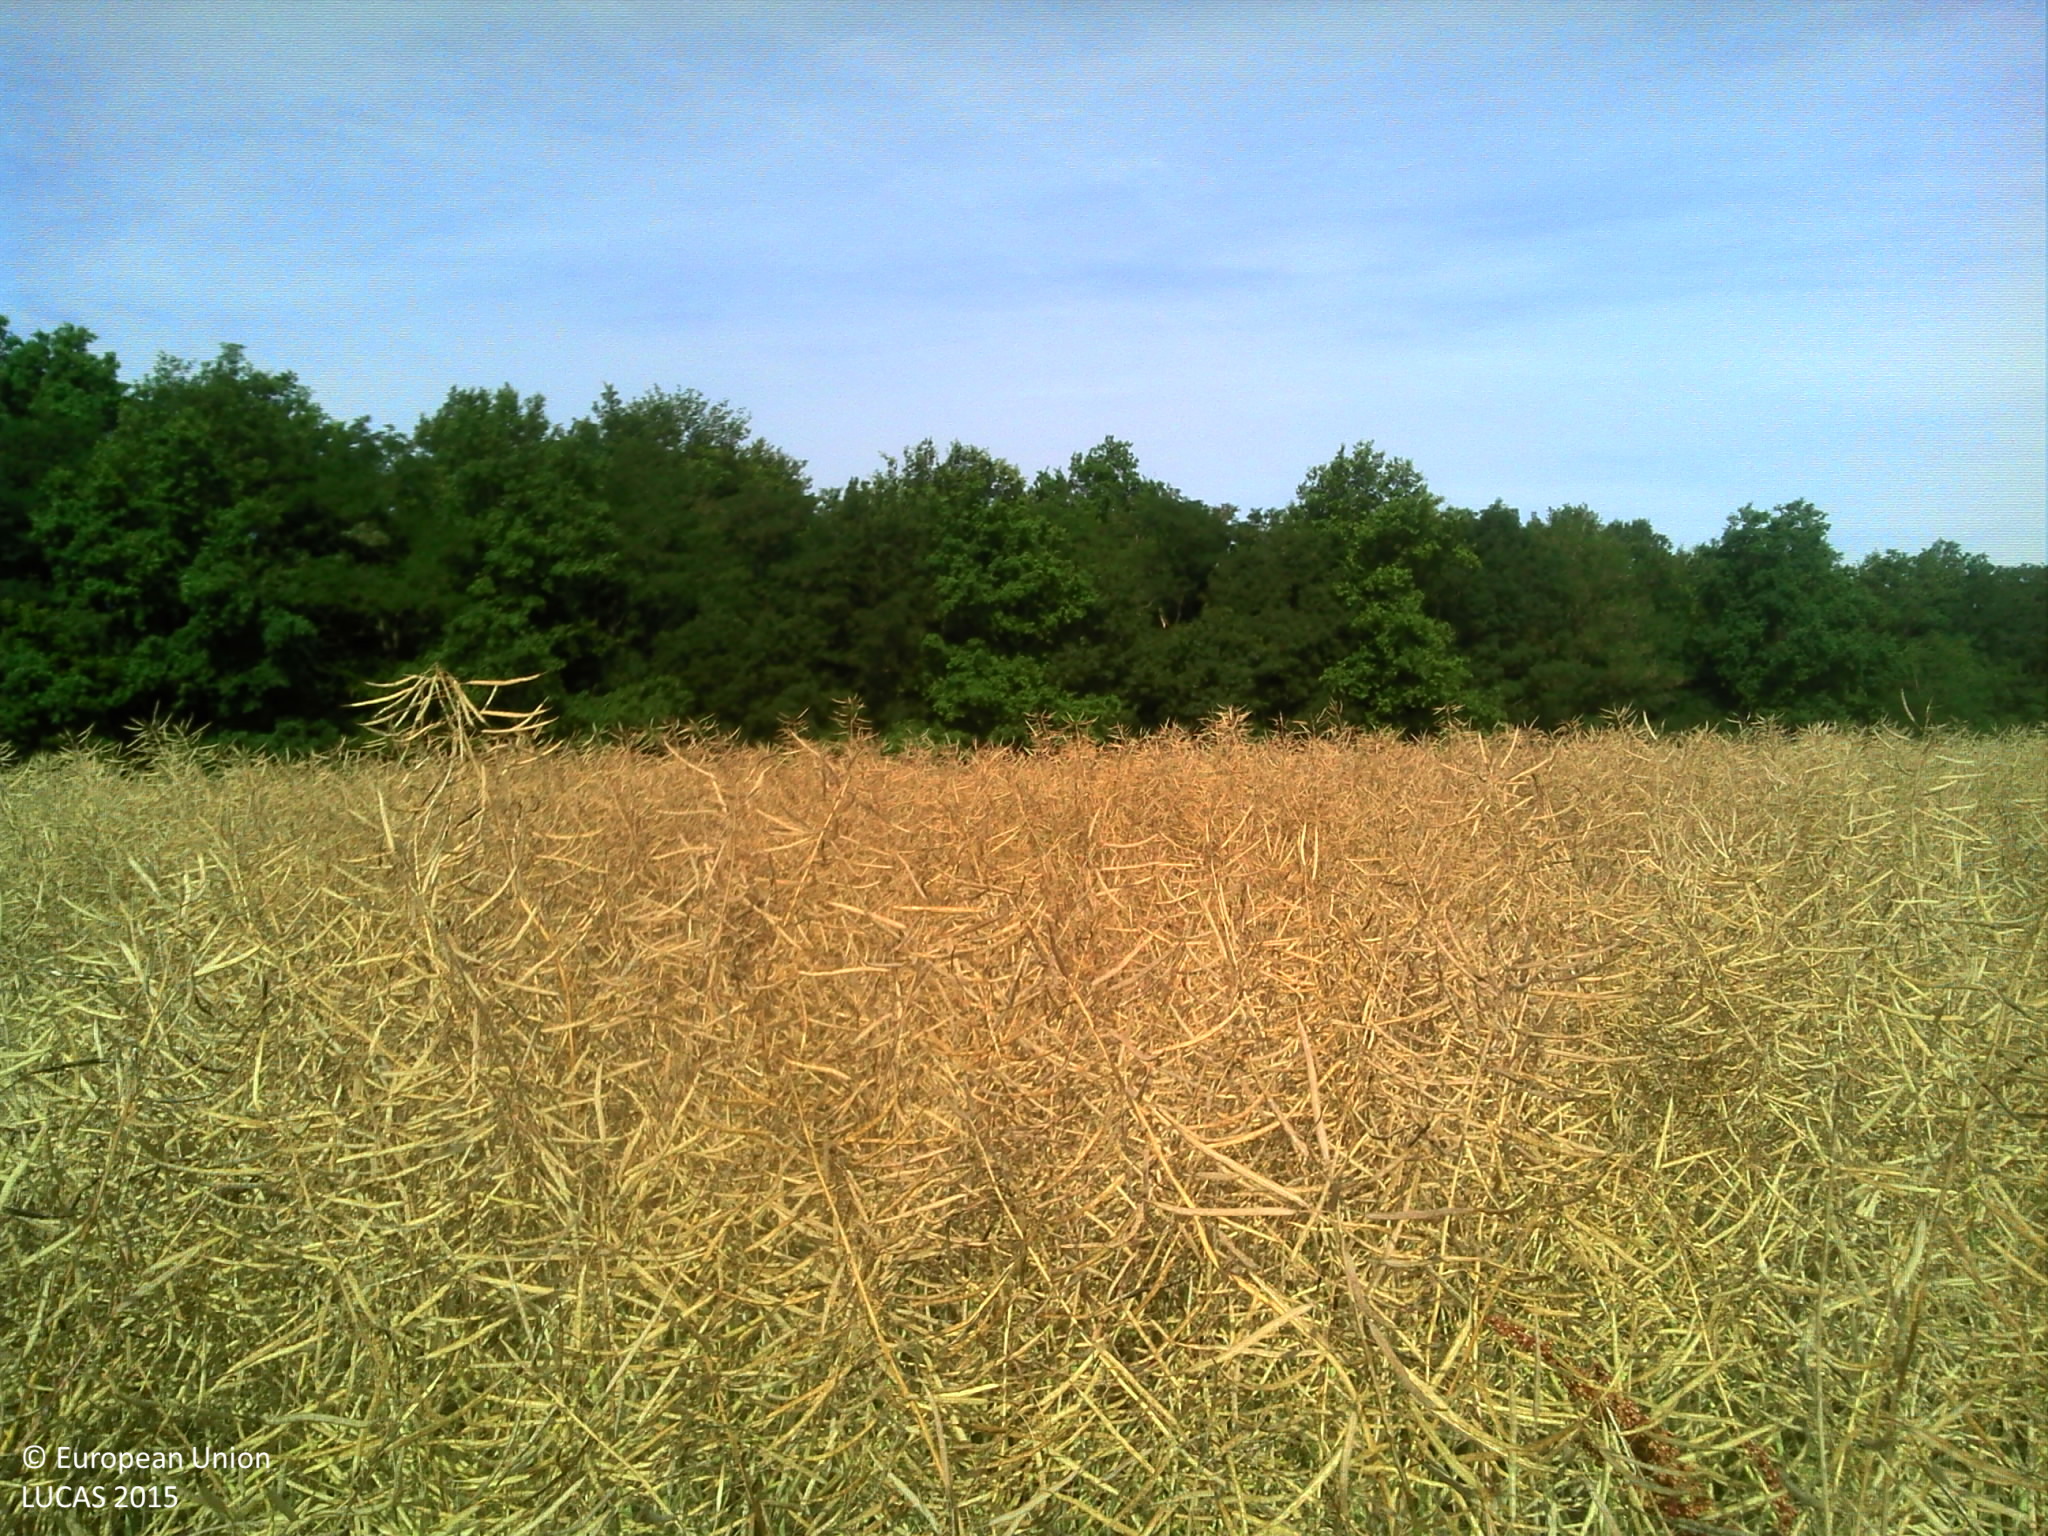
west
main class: Cropland
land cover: Rape and turnip rape
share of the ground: > 75 %
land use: Agriculture (excluding fallow land and kitchen gardens)
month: June
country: FR
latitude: 46.7136
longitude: 4.8342
